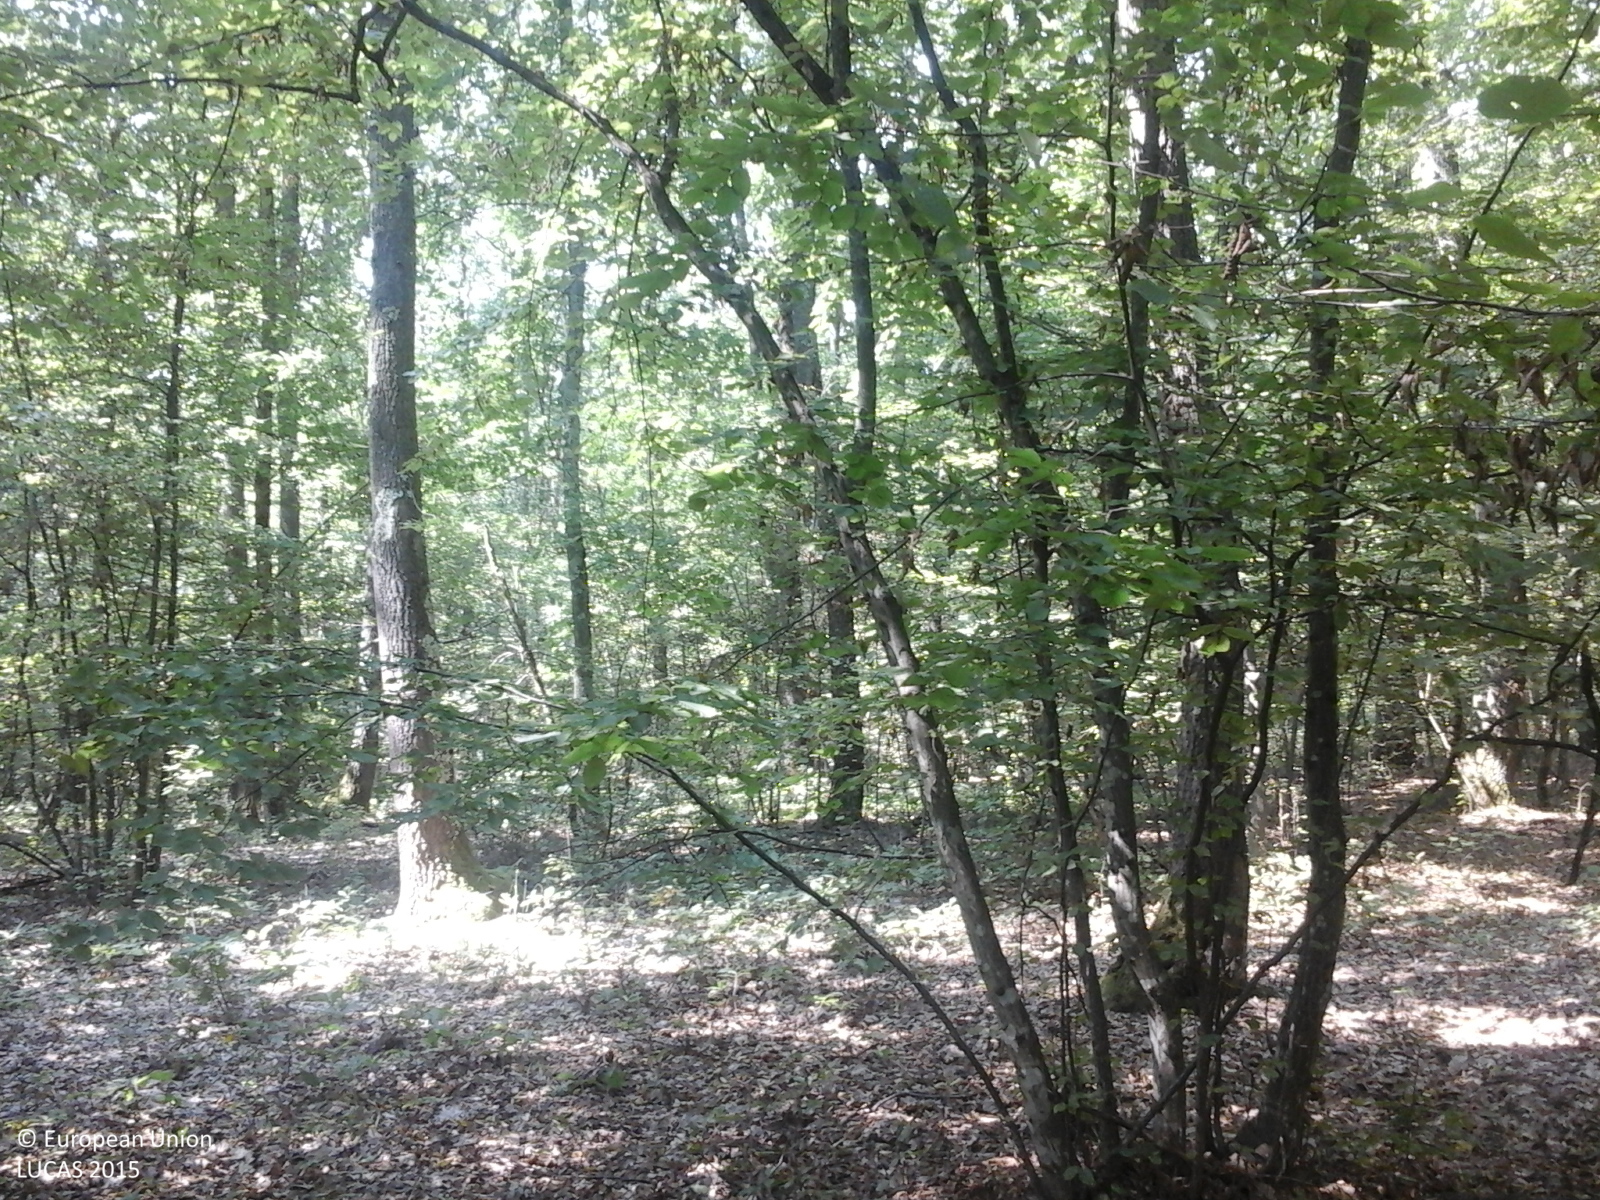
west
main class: Woodland
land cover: Broadleaved woodland
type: beech forest
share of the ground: > 75 %
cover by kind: broadleaved forest trees 100 %
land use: Forestry
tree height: > 5 m
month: August
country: RO
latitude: 46.3715
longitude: 21.9375
